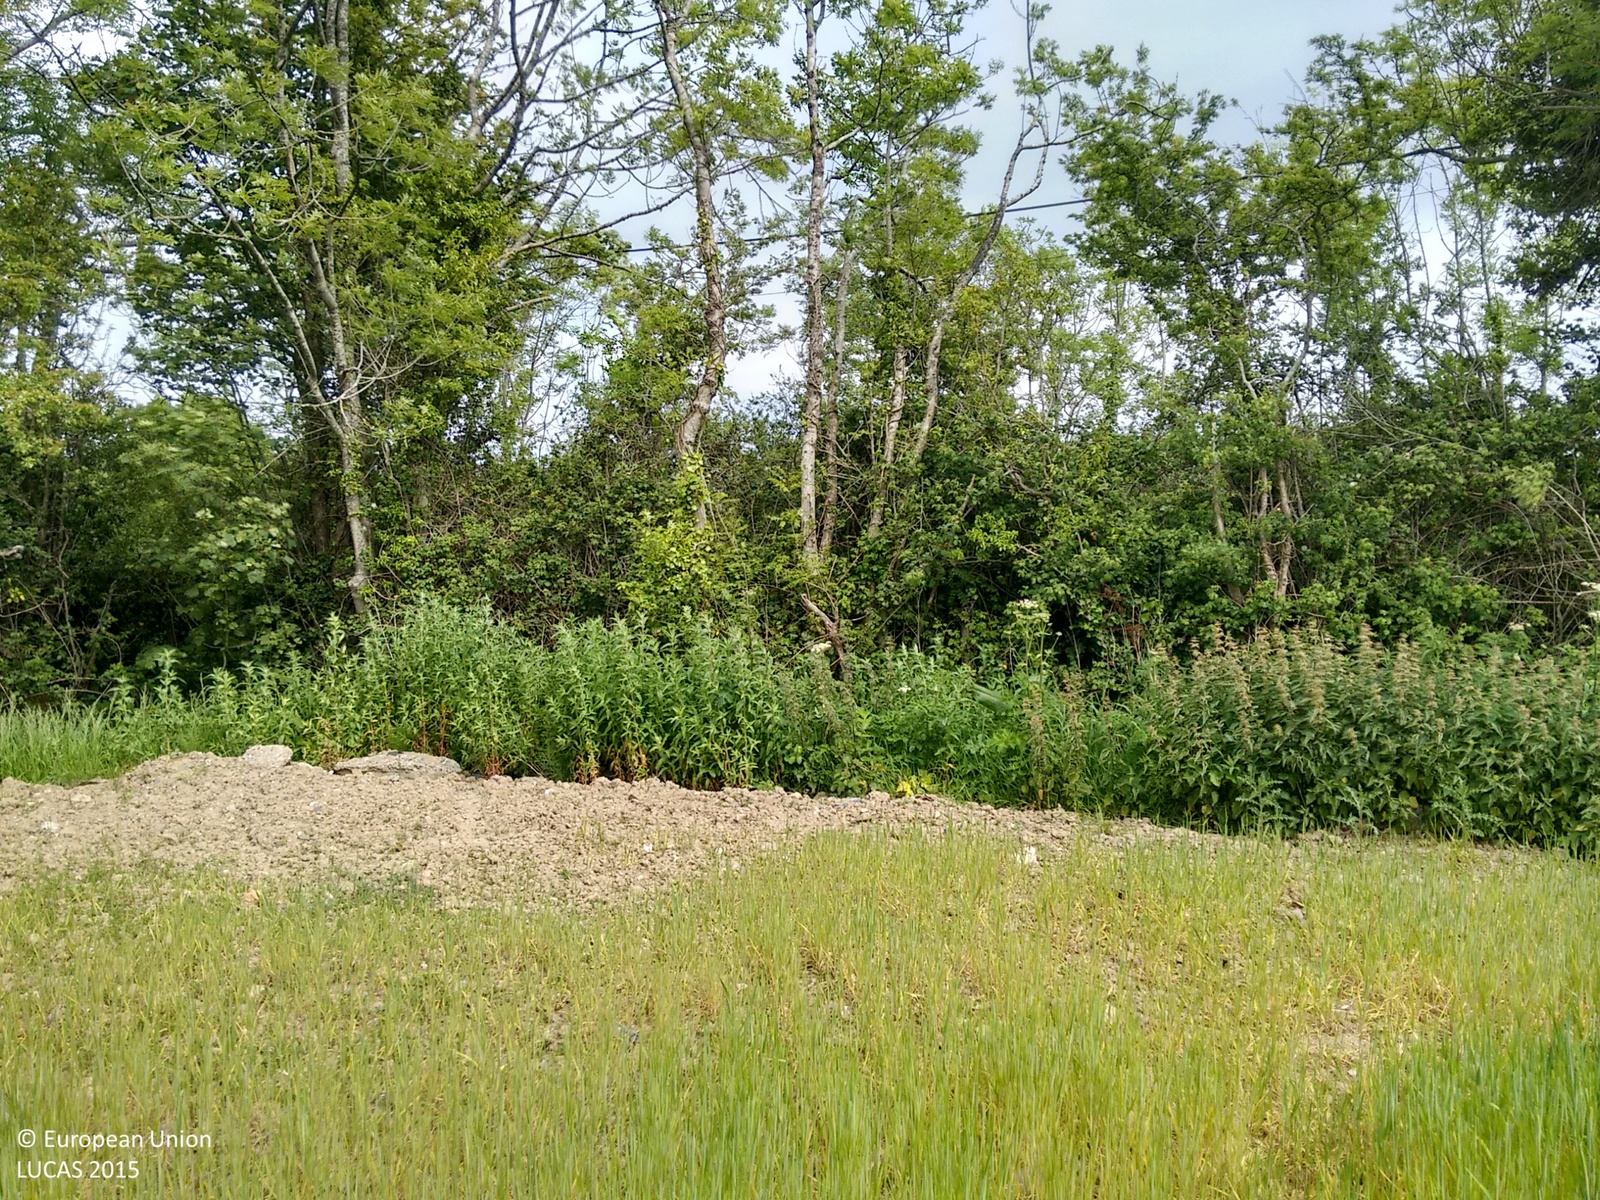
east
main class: Cropland
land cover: Common wheat
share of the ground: > 75 %
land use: Agriculture (excluding fallow land and kitchen gardens)
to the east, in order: Common wheat; Ditches and canals; Abandoned hedges; Electric lines; Paved roads, cycling and walking lanes; Abandoned hedges; Grassland without tree/shrub cover; Electric lines; Abandoned hedges; Ditches and canals; Common wheat
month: June
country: IE
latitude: 53.5369
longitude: -6.1557
